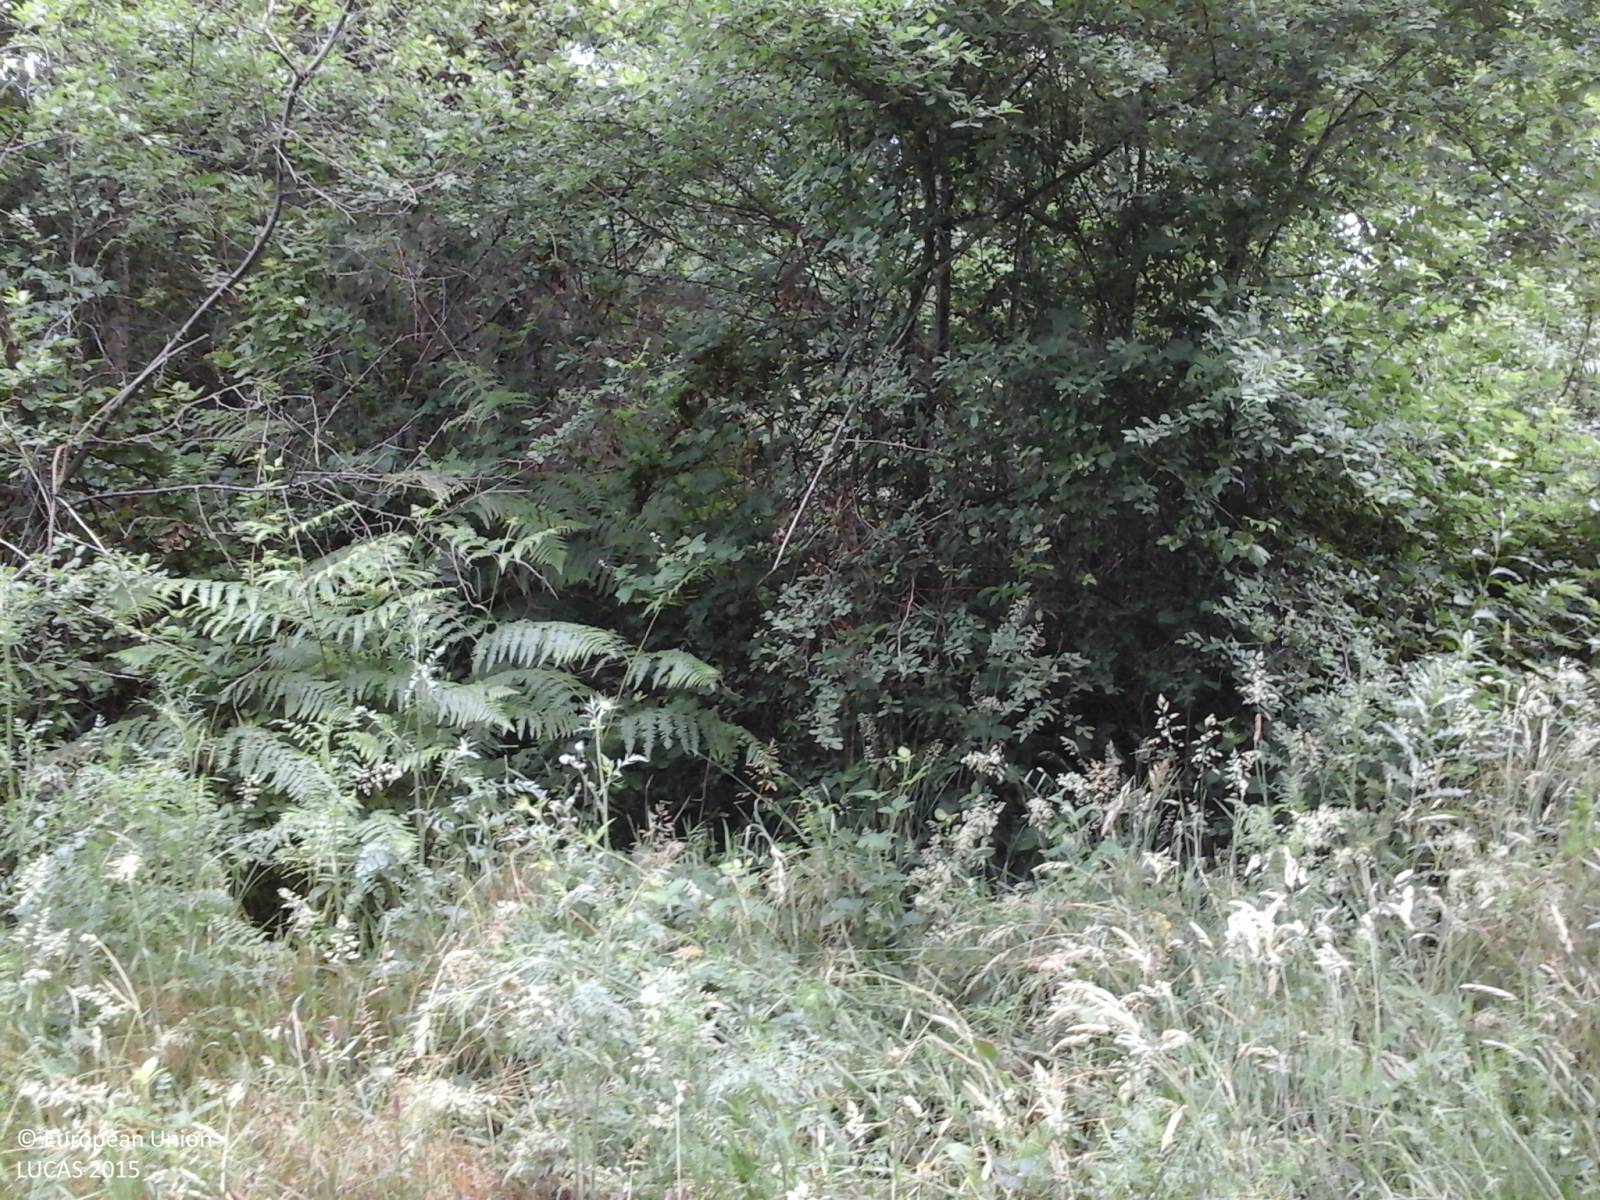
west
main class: Woodland
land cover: Broadleaved woodland
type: thermophilous deciduous forest
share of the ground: > 75 %
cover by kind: broadleaved forest trees 80 %, coniferous forest trees 20 %
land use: Forestry
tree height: > 5 m
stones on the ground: 25 - 50 %
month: June
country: IT
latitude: 42.3960
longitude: 12.1671
